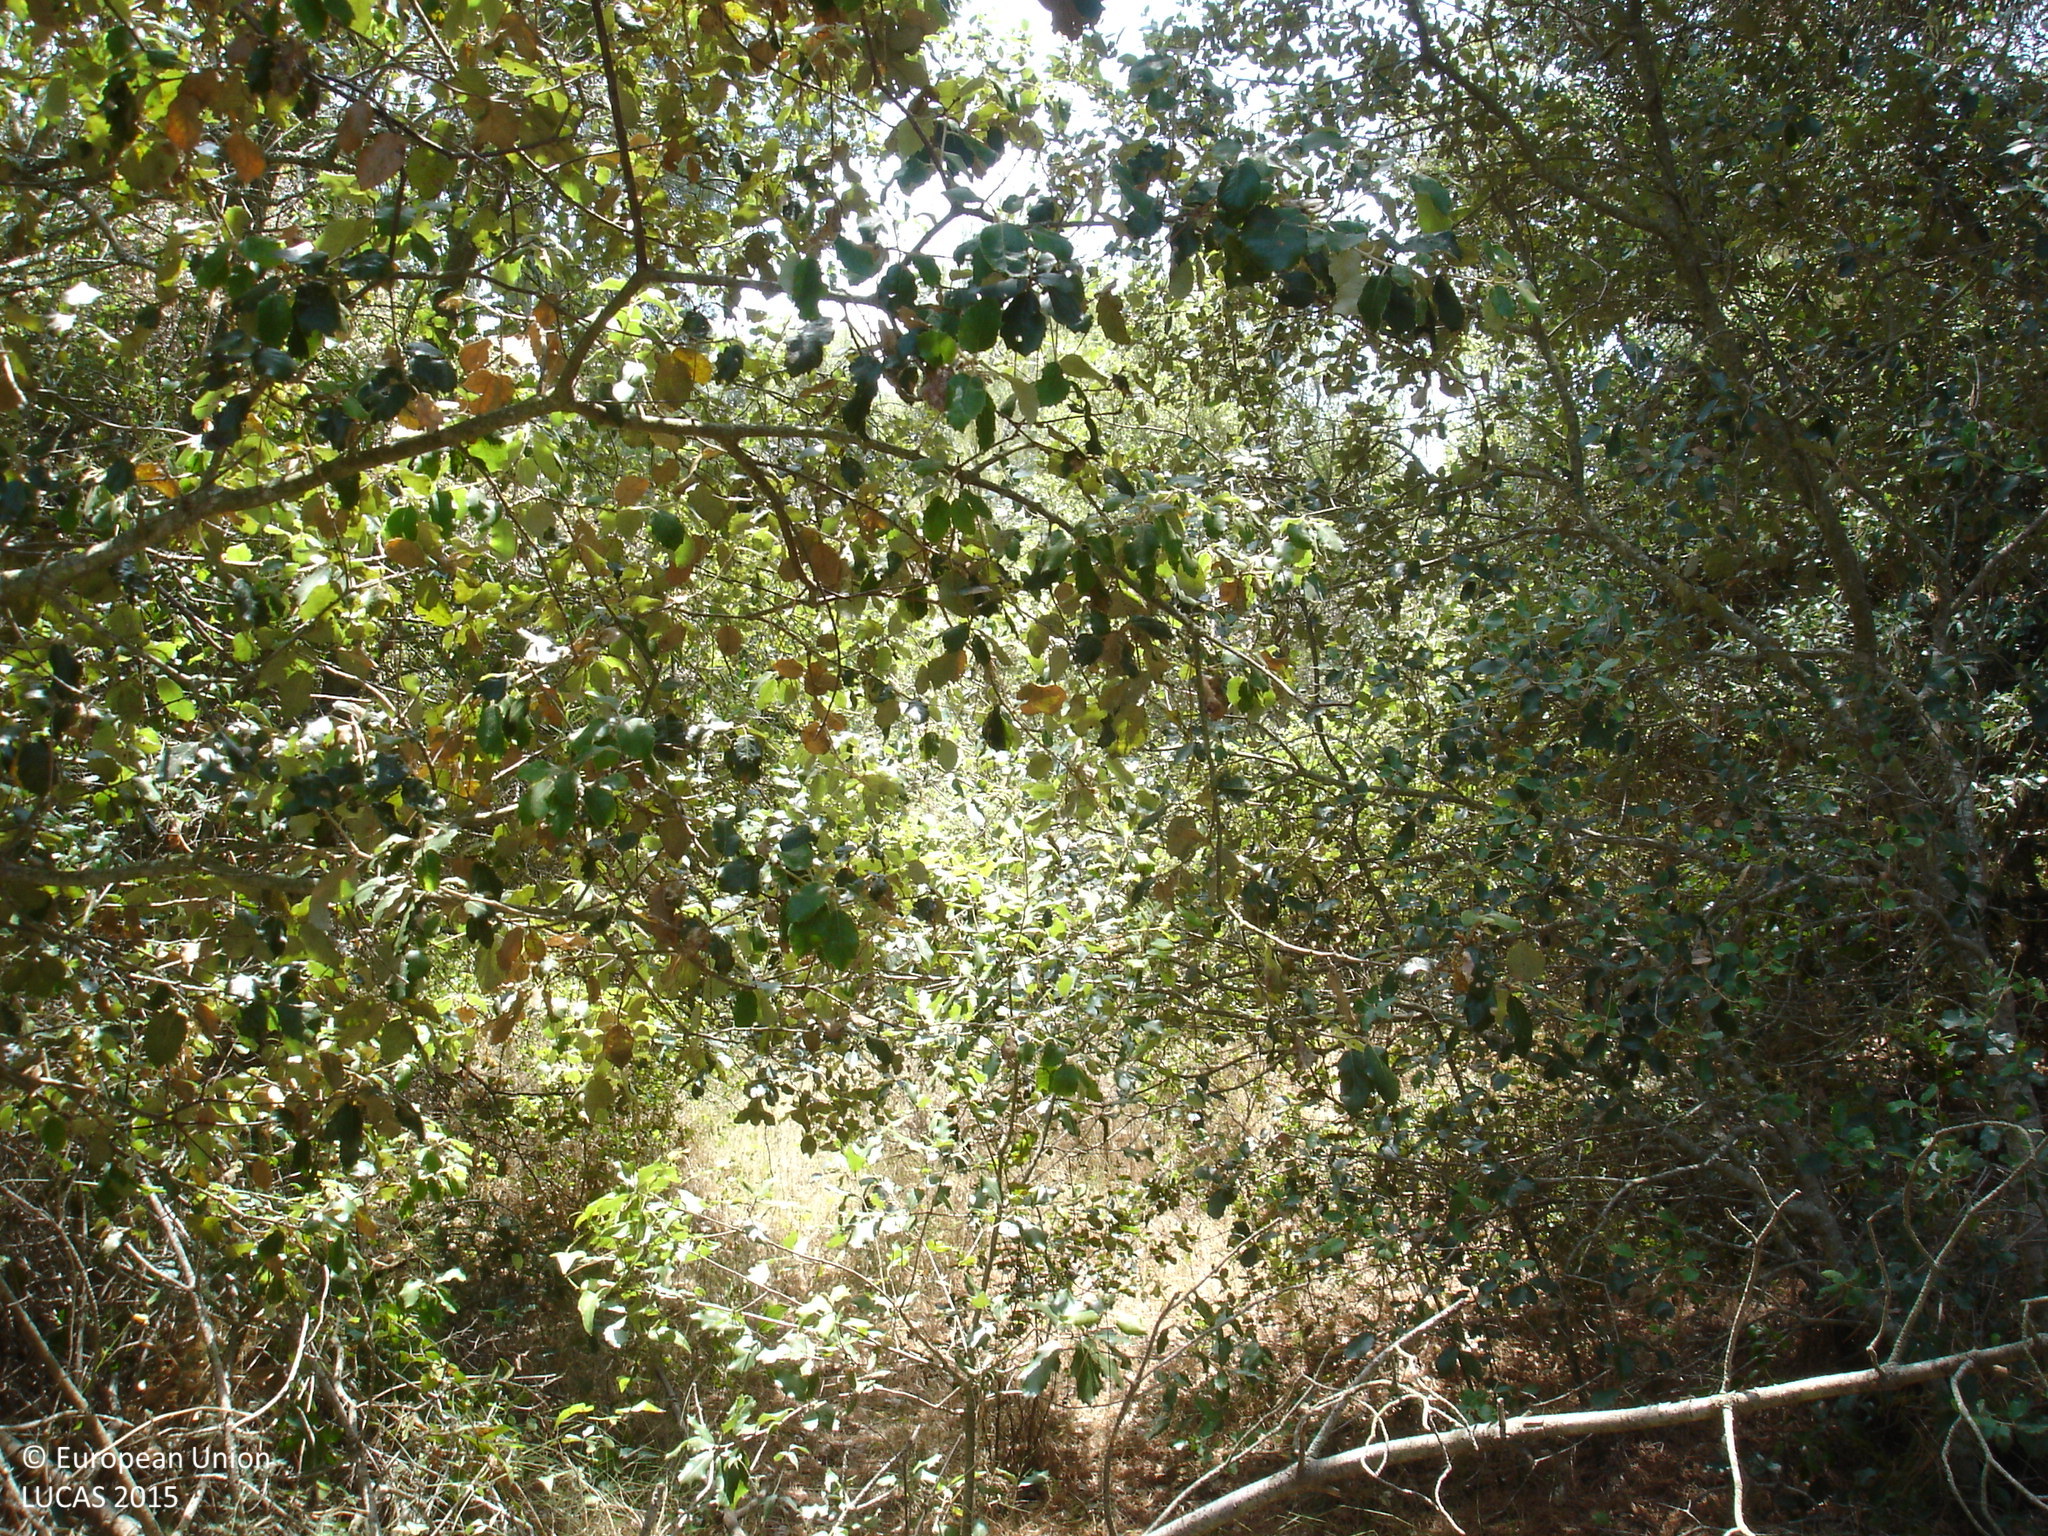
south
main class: Woodland
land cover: Other mixed woodland
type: thermophilous deciduous forest
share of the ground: > 75 %
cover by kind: broadleaved forest trees 50 %, coniferous forest trees 30 %, herbaceous plants 20 %
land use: Forestry
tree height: > 5 m
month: July
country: ES
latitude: 41.8577
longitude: 3.1142
